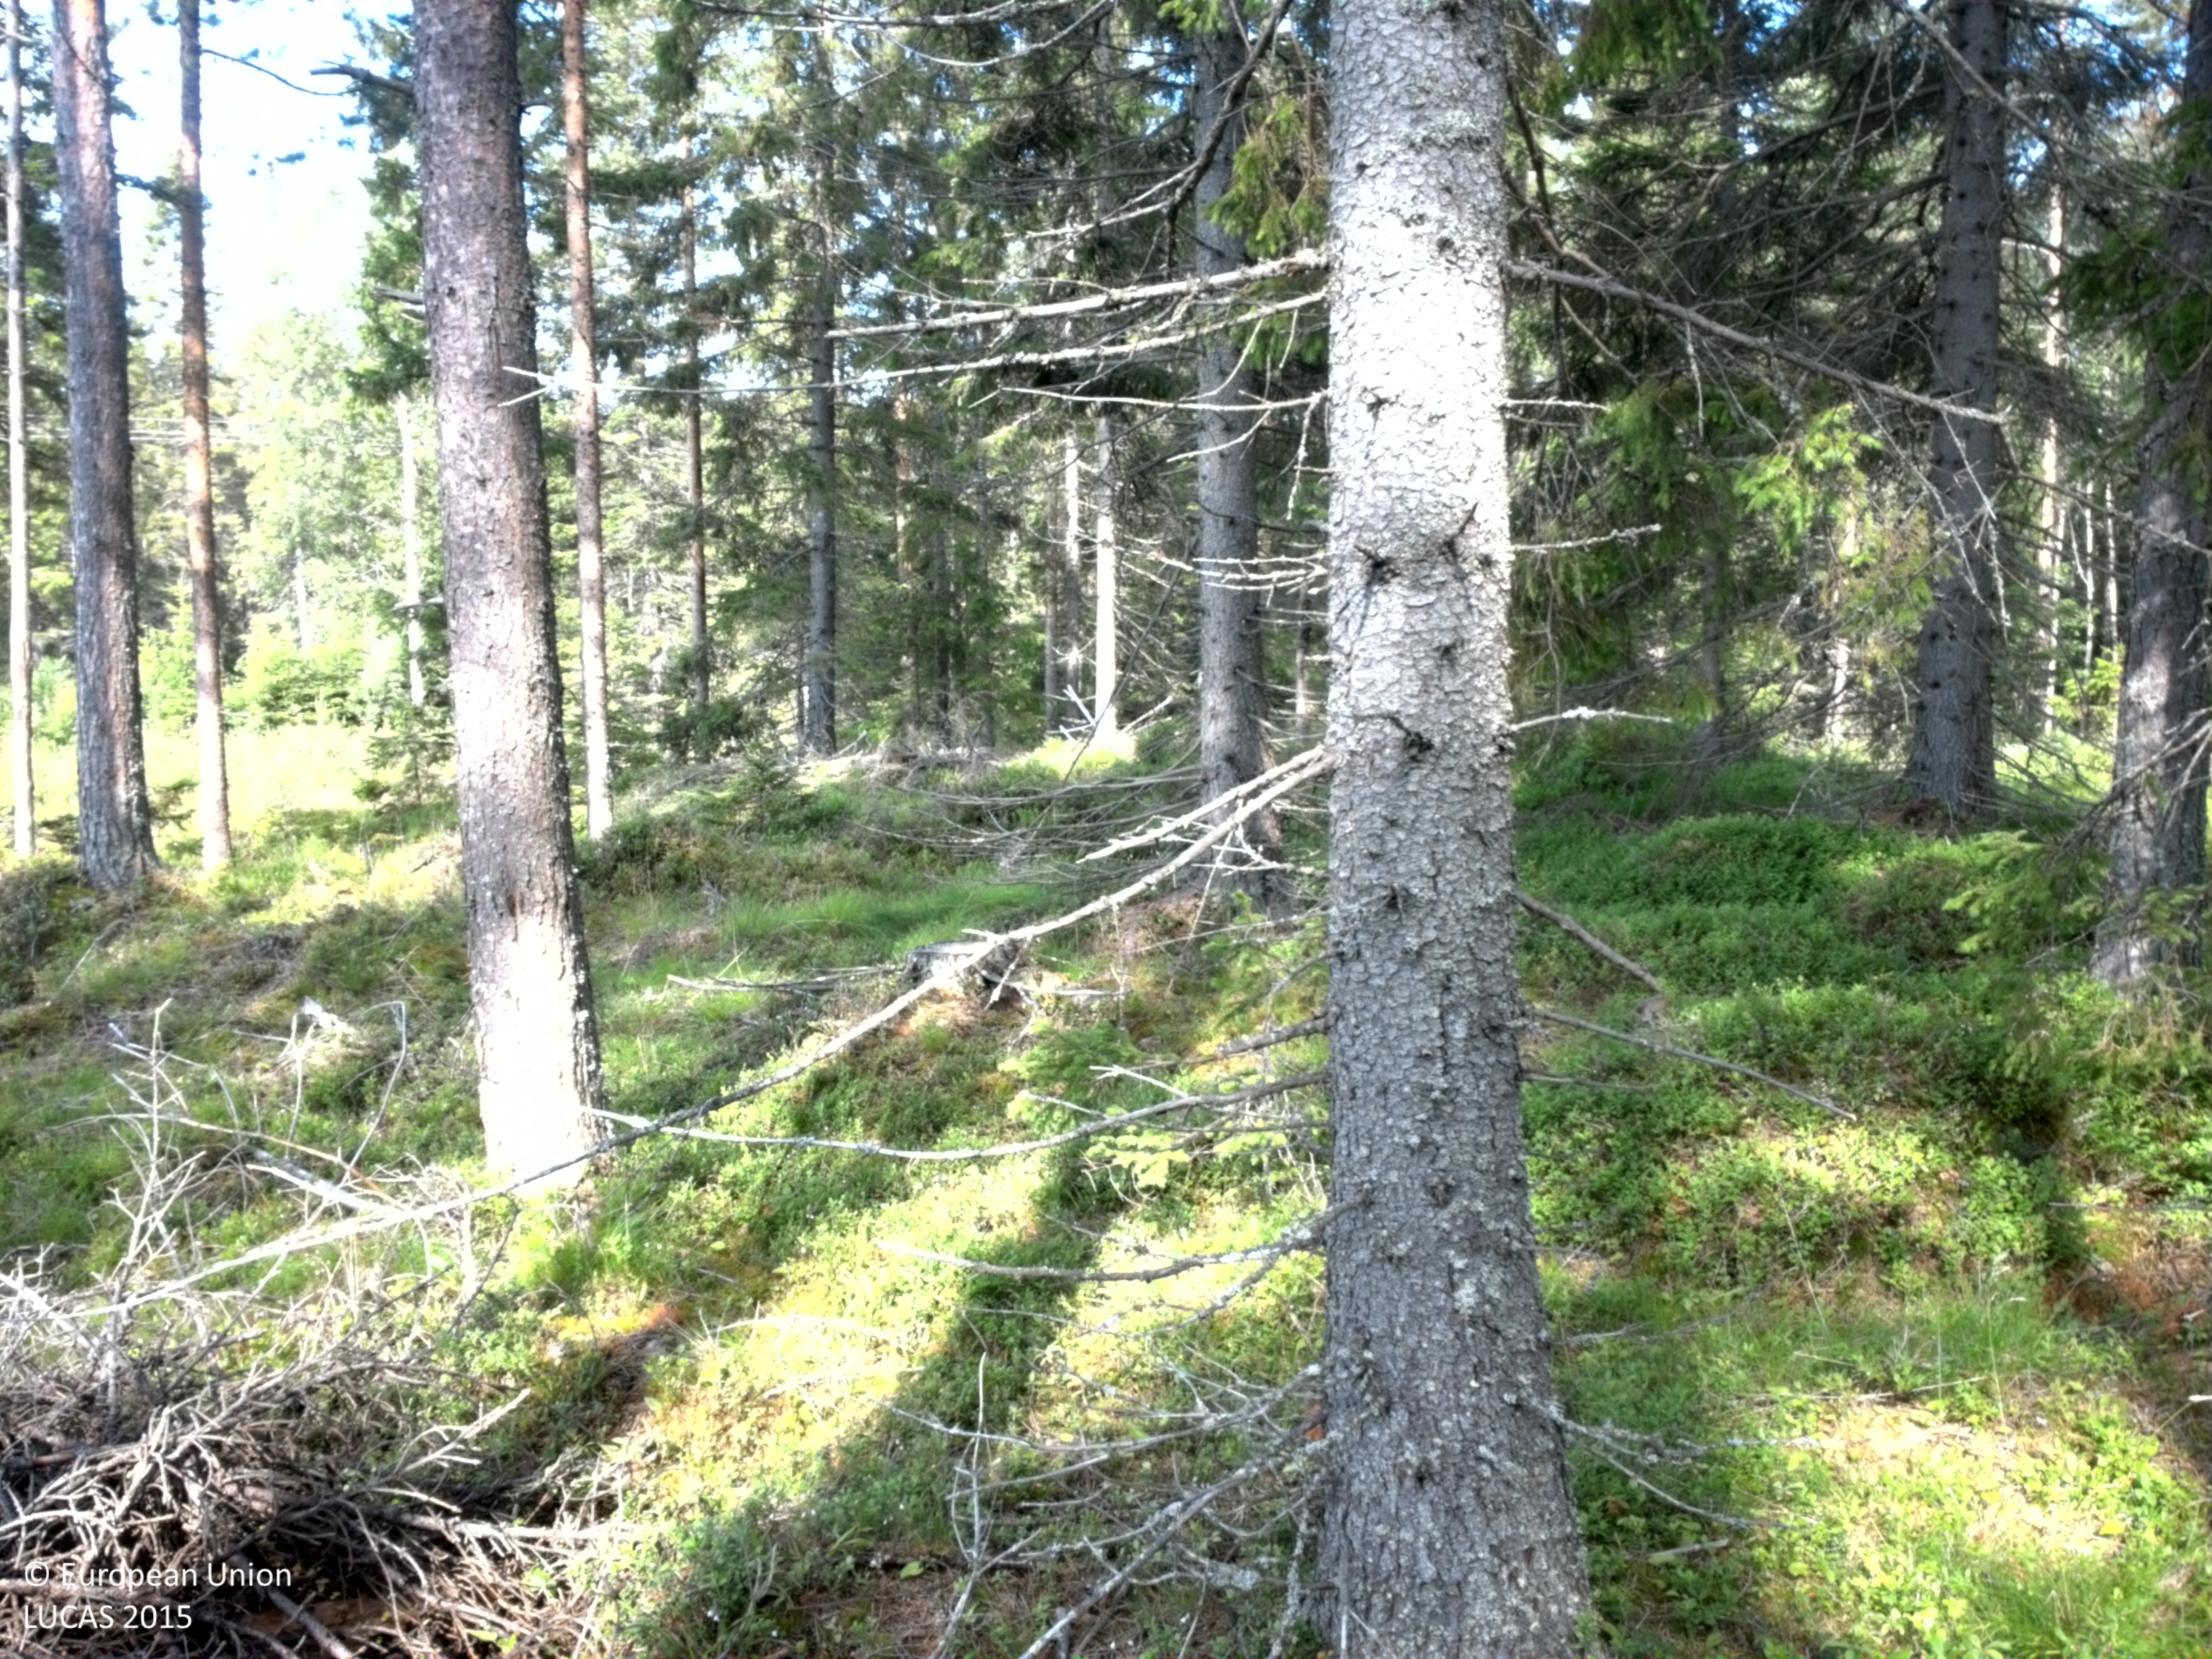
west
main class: Woodland
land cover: Pine dominated coniferous woodland
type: boreal forest
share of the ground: 50 - 75 %
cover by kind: coniferous forest trees 65 %, shrubs 35 %
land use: Forestry
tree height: > 5 m
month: July
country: SE
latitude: 64.4499
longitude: 21.5611
